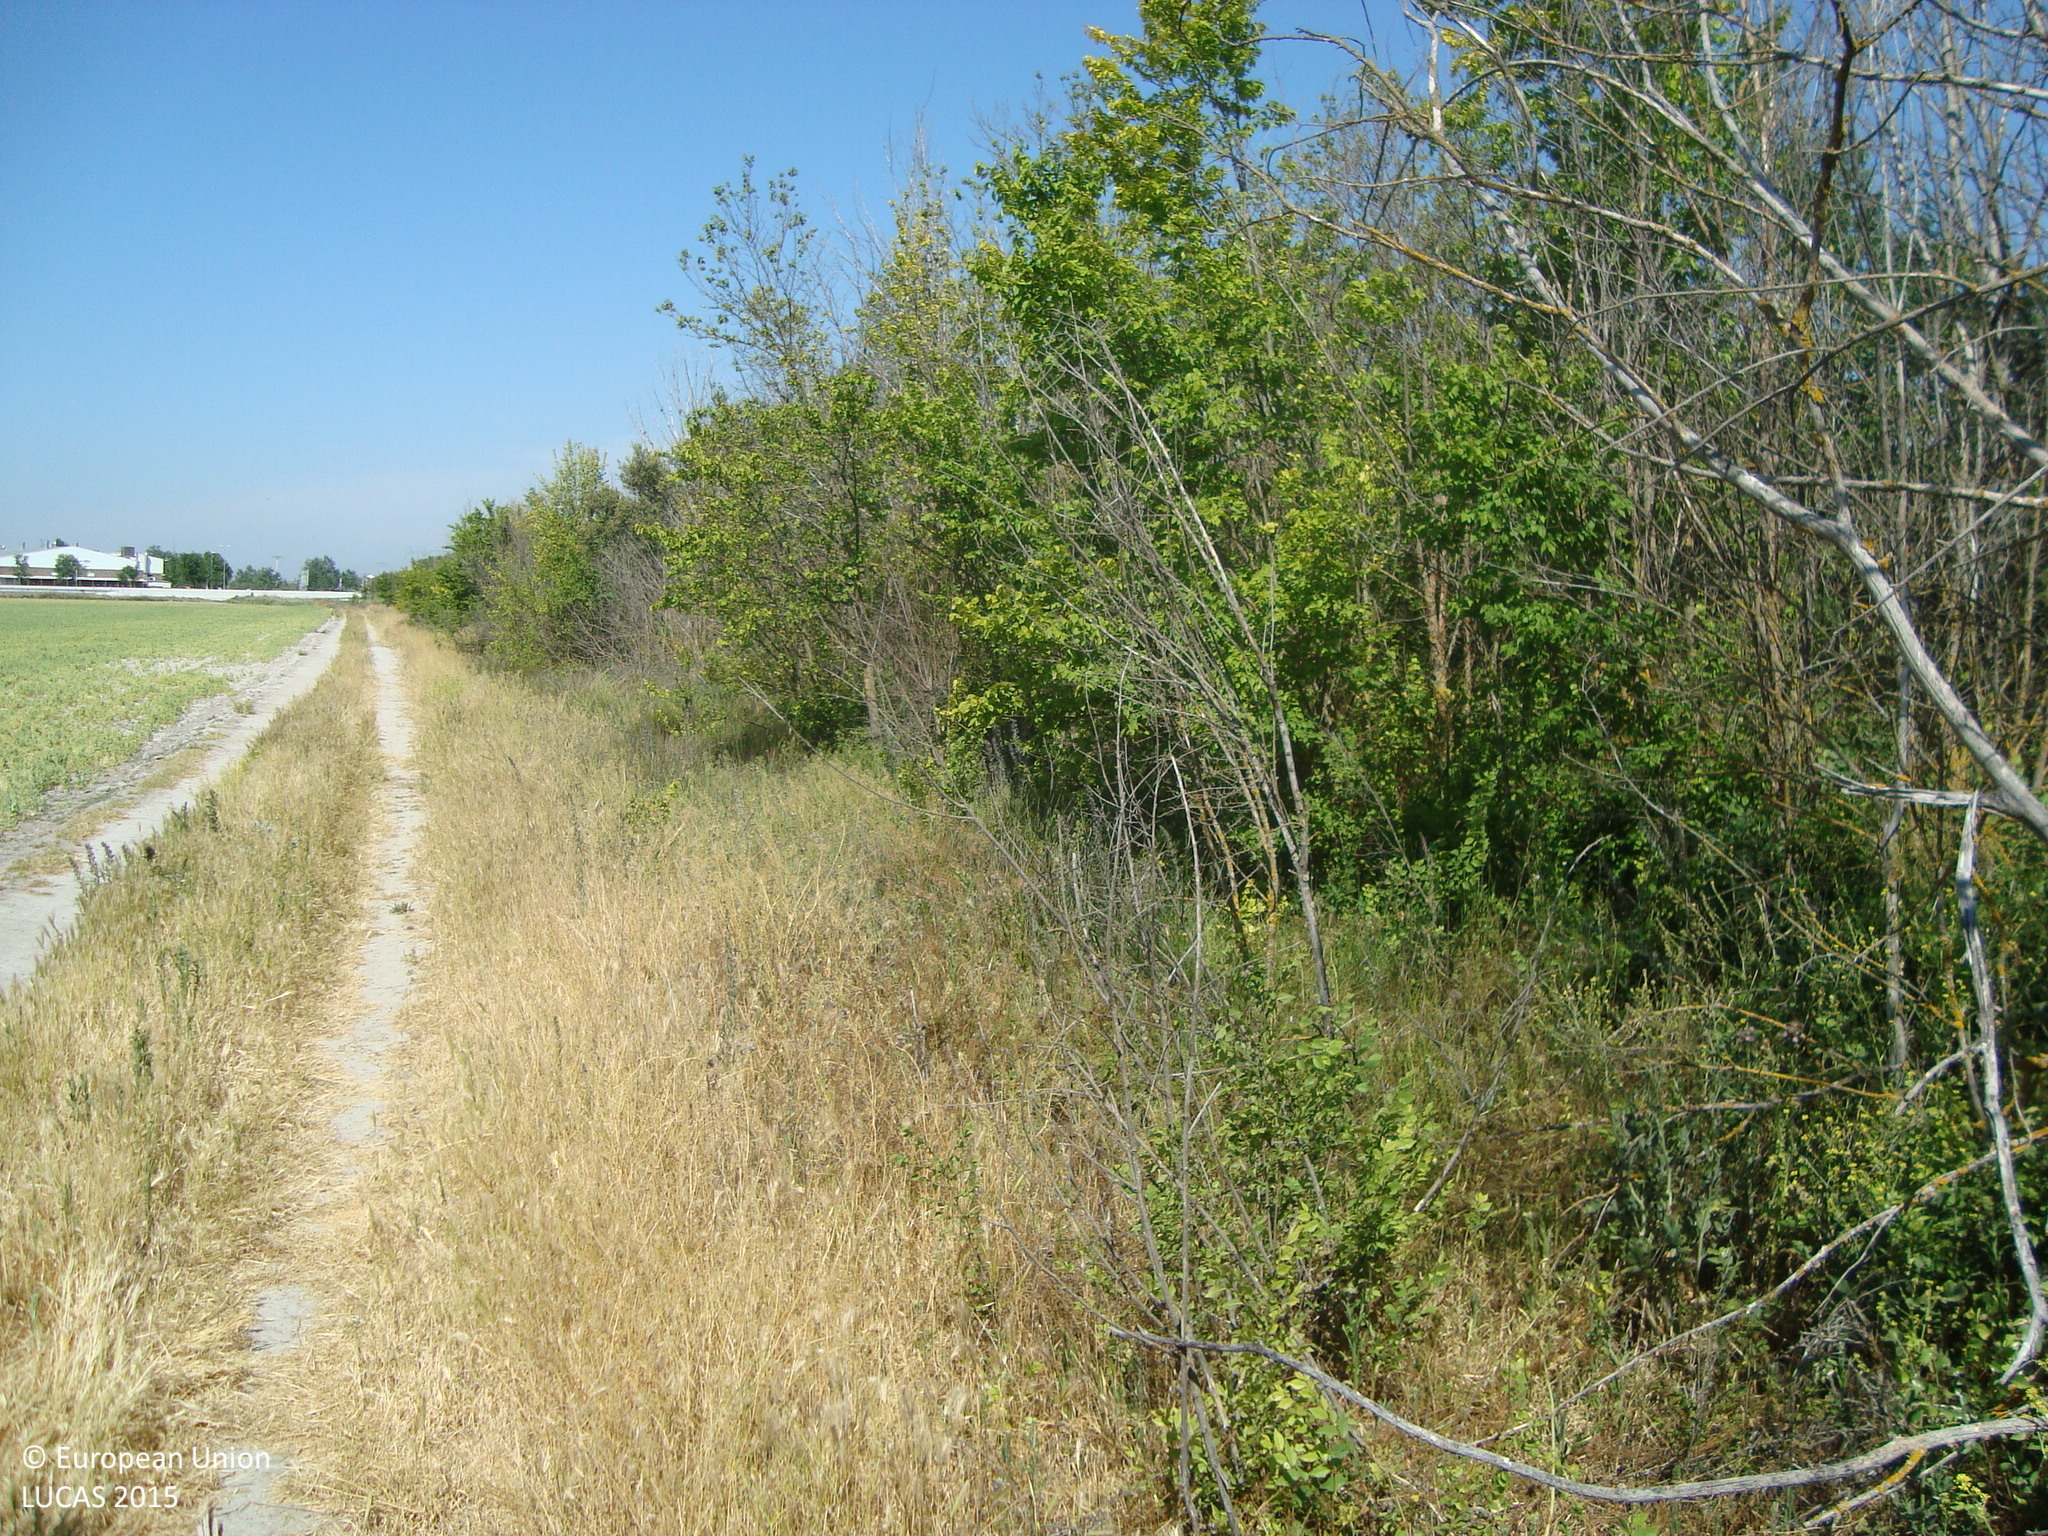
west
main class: Woodland
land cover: Broadleaved woodland
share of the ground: 10 - 25 %
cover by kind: herbaceous plants 75 %, broadleaved forest trees 20 %, shrubs 5 %
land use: Semi-natural and natural areas not in use
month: June
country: ES
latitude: 41.5447
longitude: -4.6556
